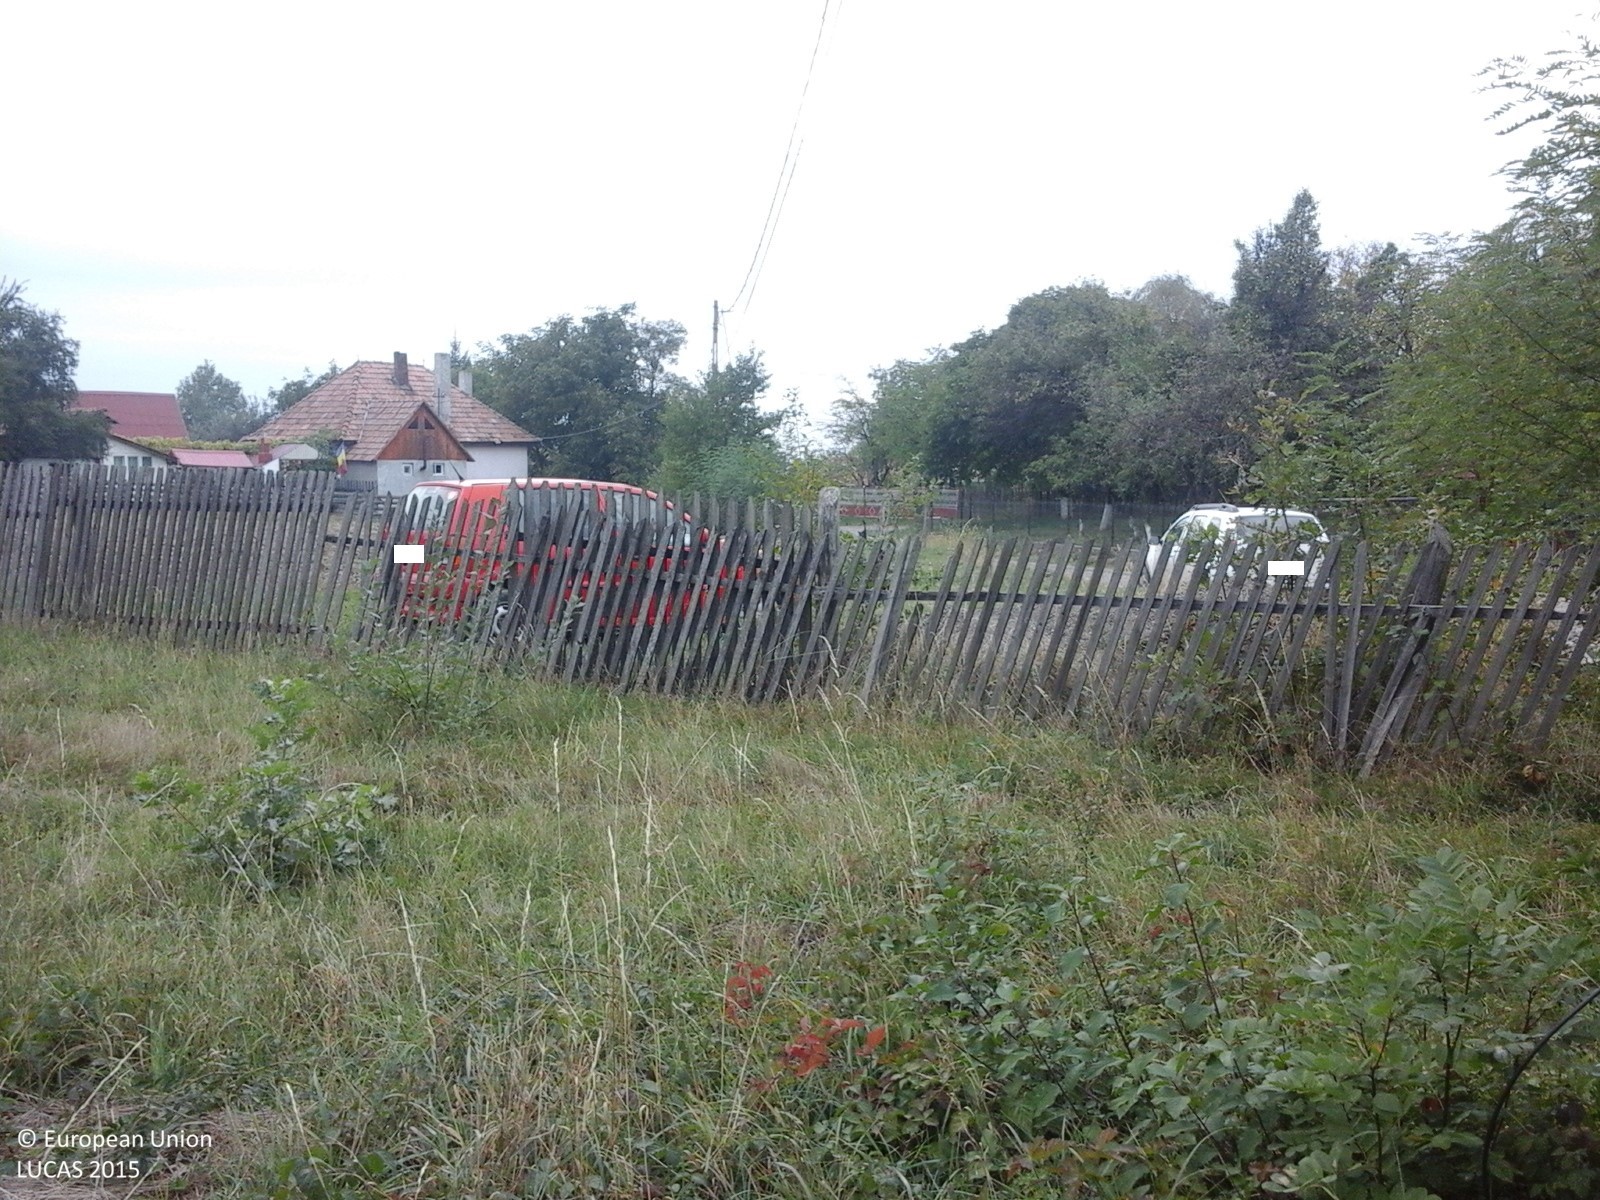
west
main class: Grassland
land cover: Spontaneously vegetated surfaces
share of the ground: > 75 %
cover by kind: herbaceous plants 100 %
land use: Agriculture (excluding fallow land and kitchen gardens)
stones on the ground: < 10 %
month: October
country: RO
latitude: 46.7740
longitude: 24.9626
